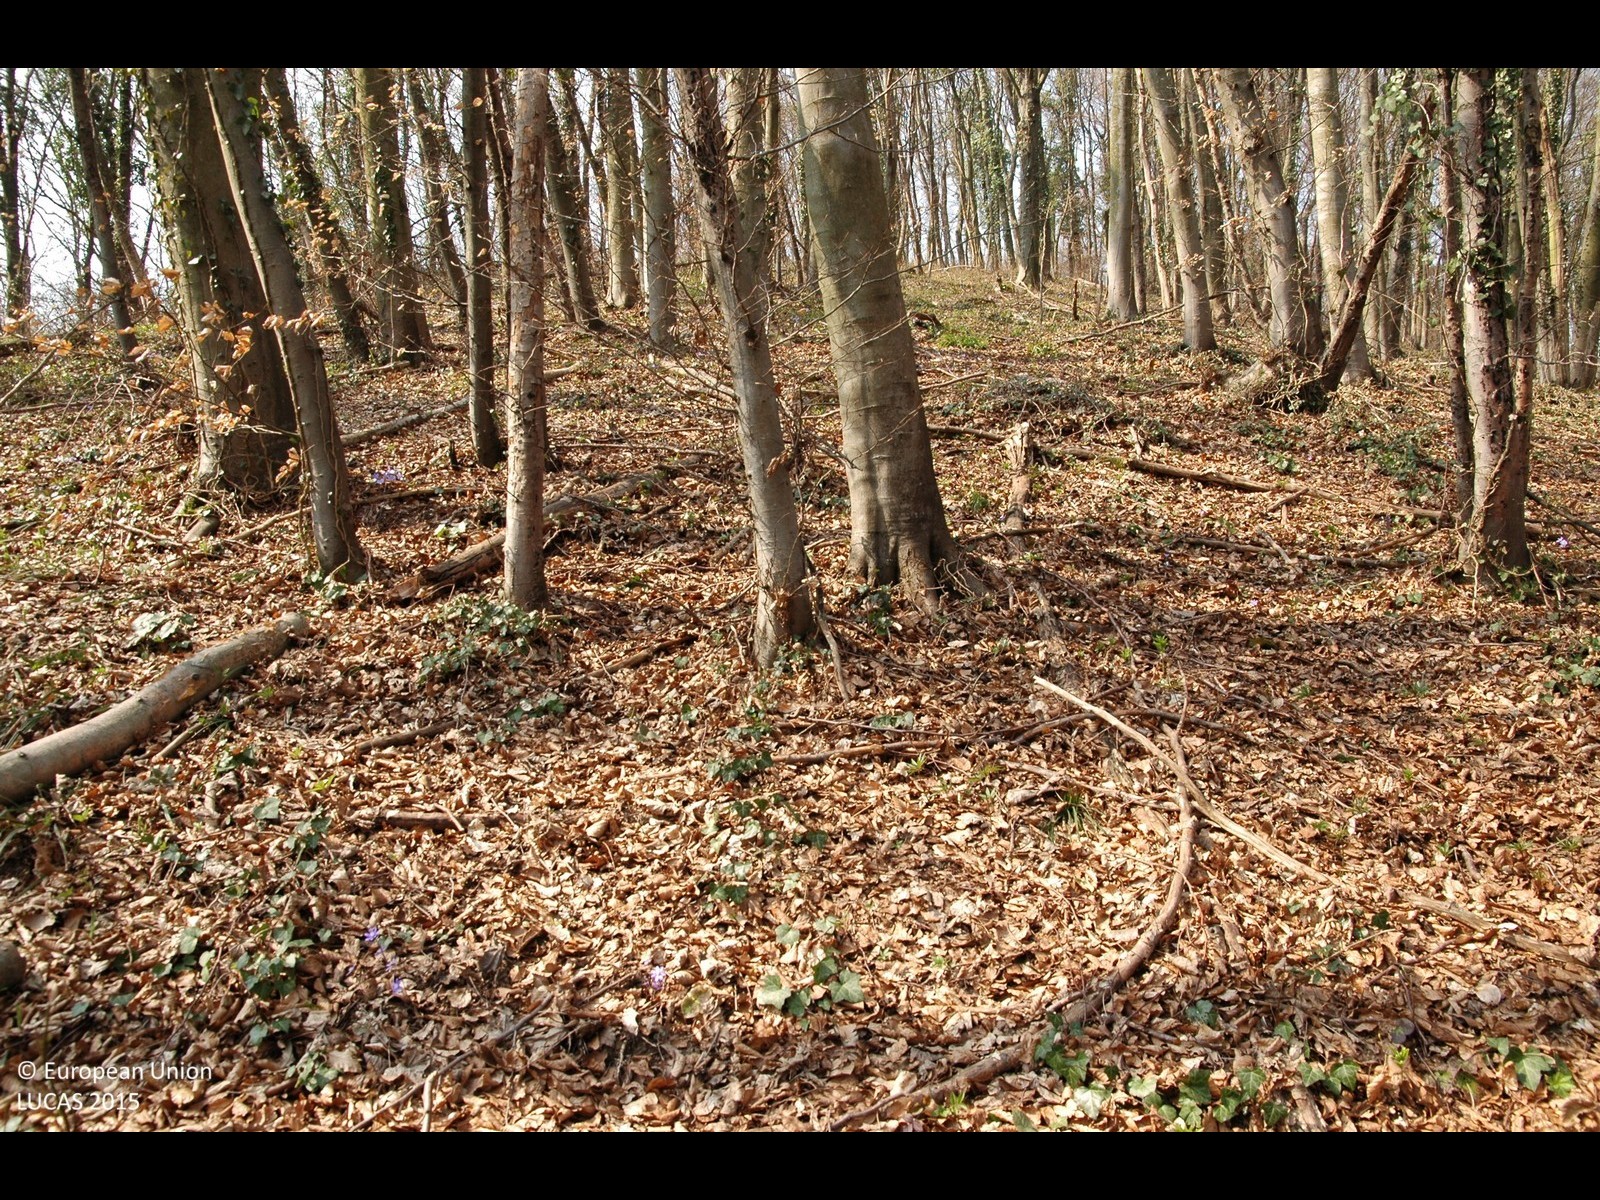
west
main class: Woodland
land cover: Broadleaved woodland
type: beech forest
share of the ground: > 75 %
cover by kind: broadleaved forest trees 95 %
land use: Forestry
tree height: > 5 m
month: March
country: HR
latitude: 46.1979
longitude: 16.3626
